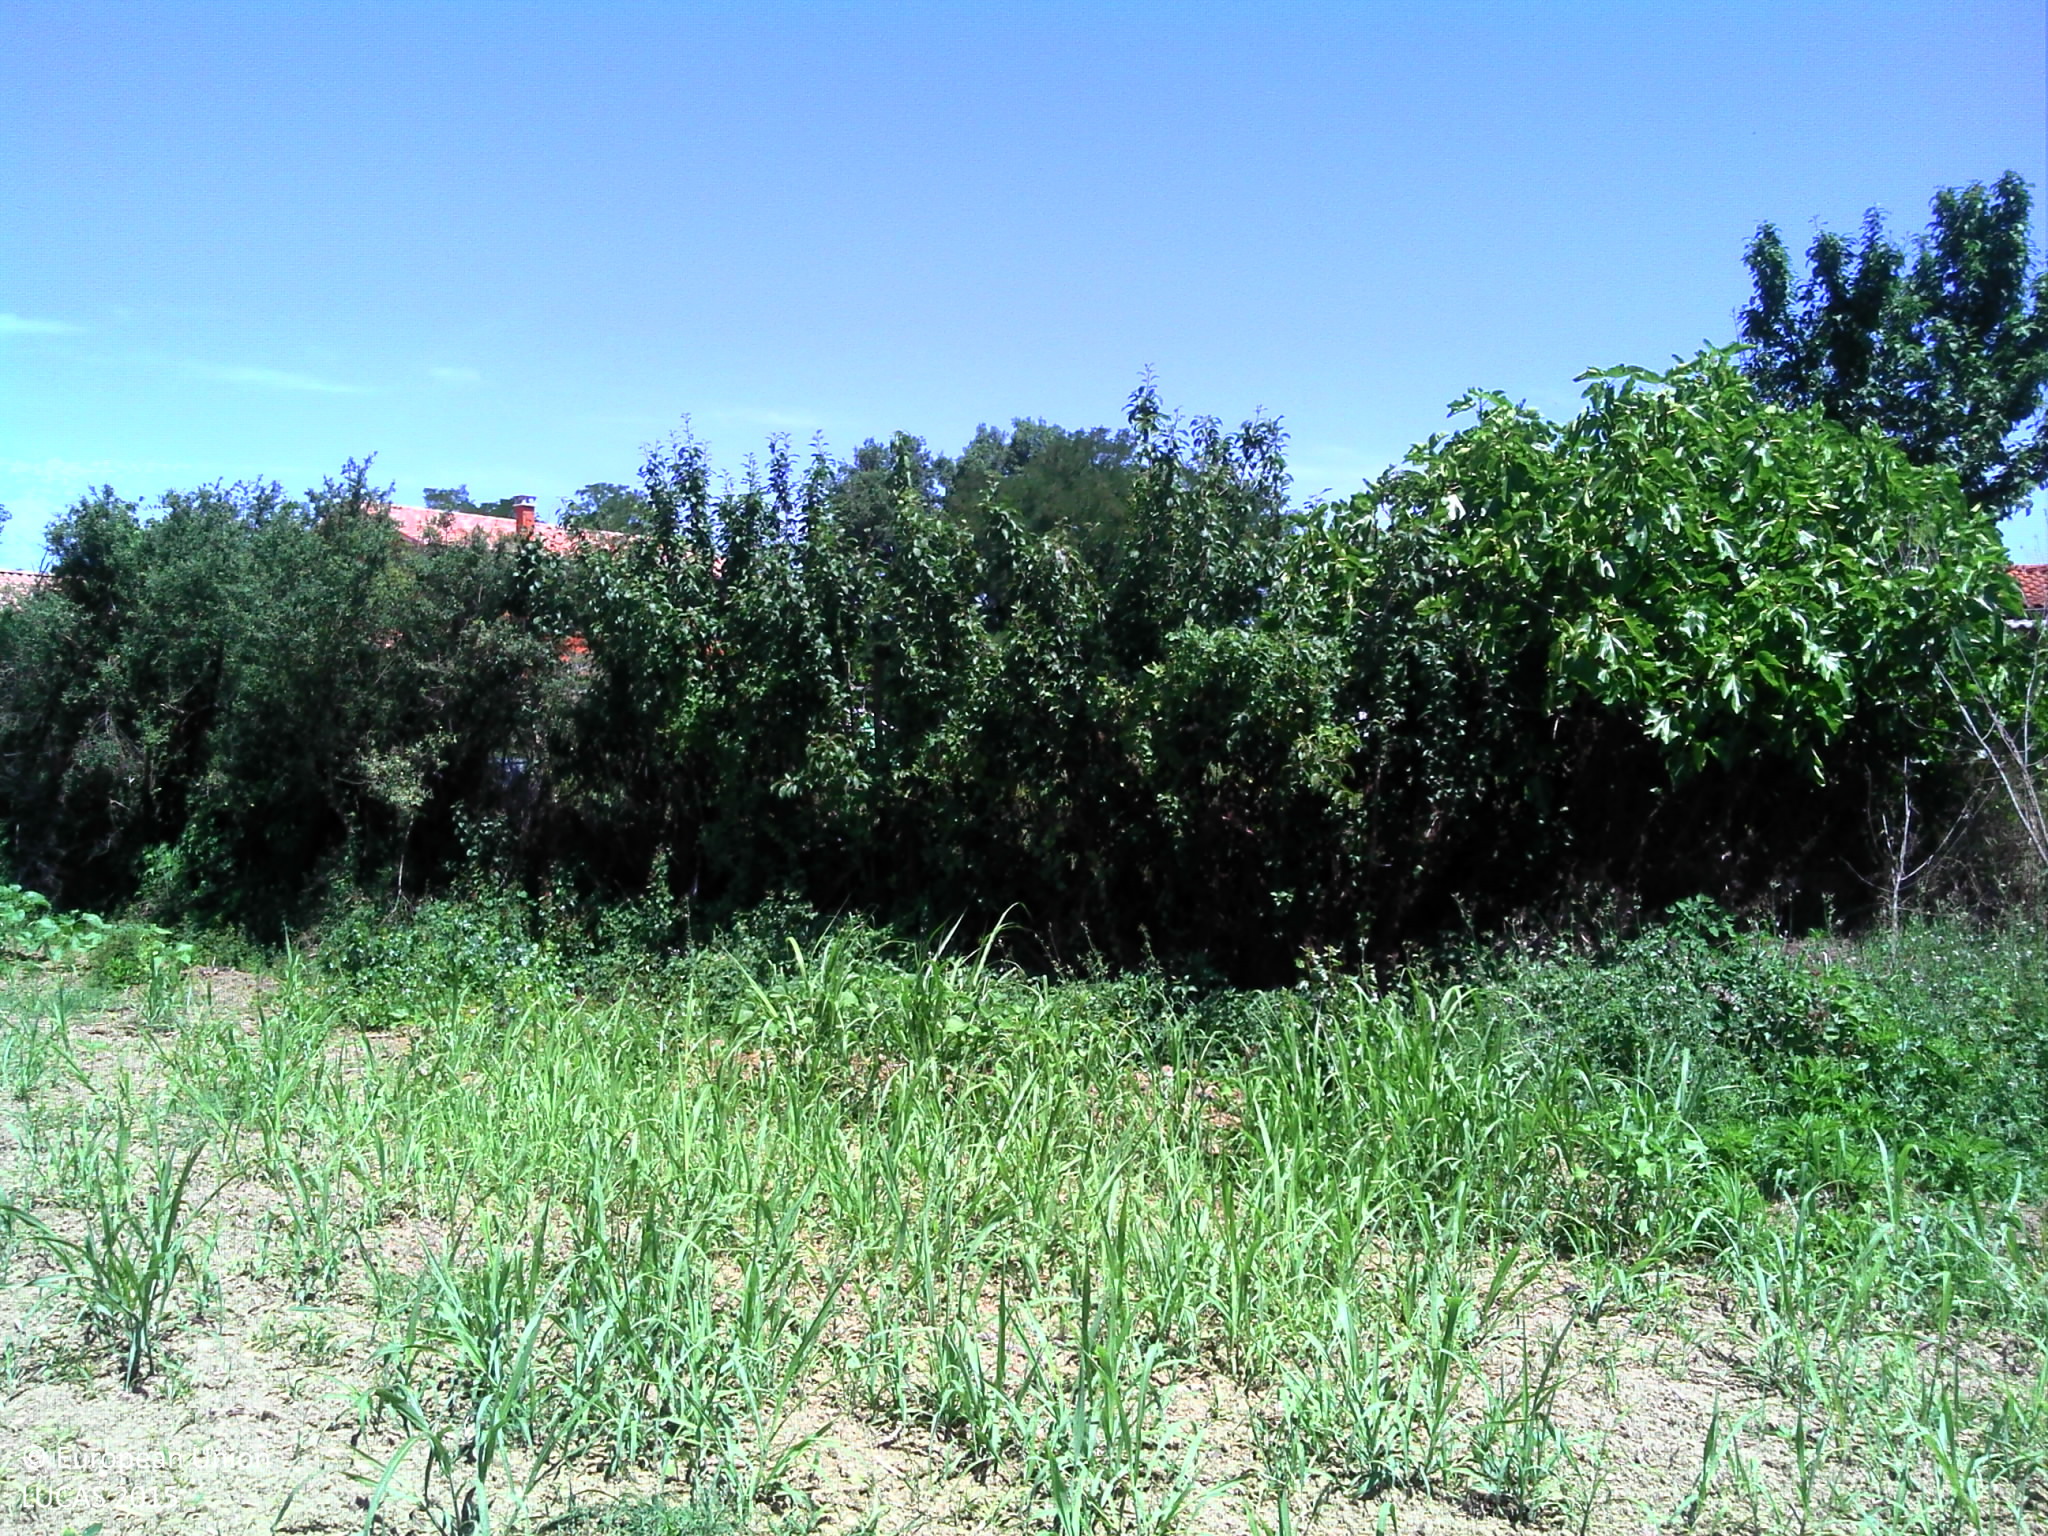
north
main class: Grassland
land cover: Spontaneously vegetated surfaces
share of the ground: 50 - 75 %
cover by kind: herbaceous plants 55 %, unconsolidated bare surface 45 %
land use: Agriculture (excluding fallow land and kitchen gardens)
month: June
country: FR
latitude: 43.7747
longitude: 1.3916
